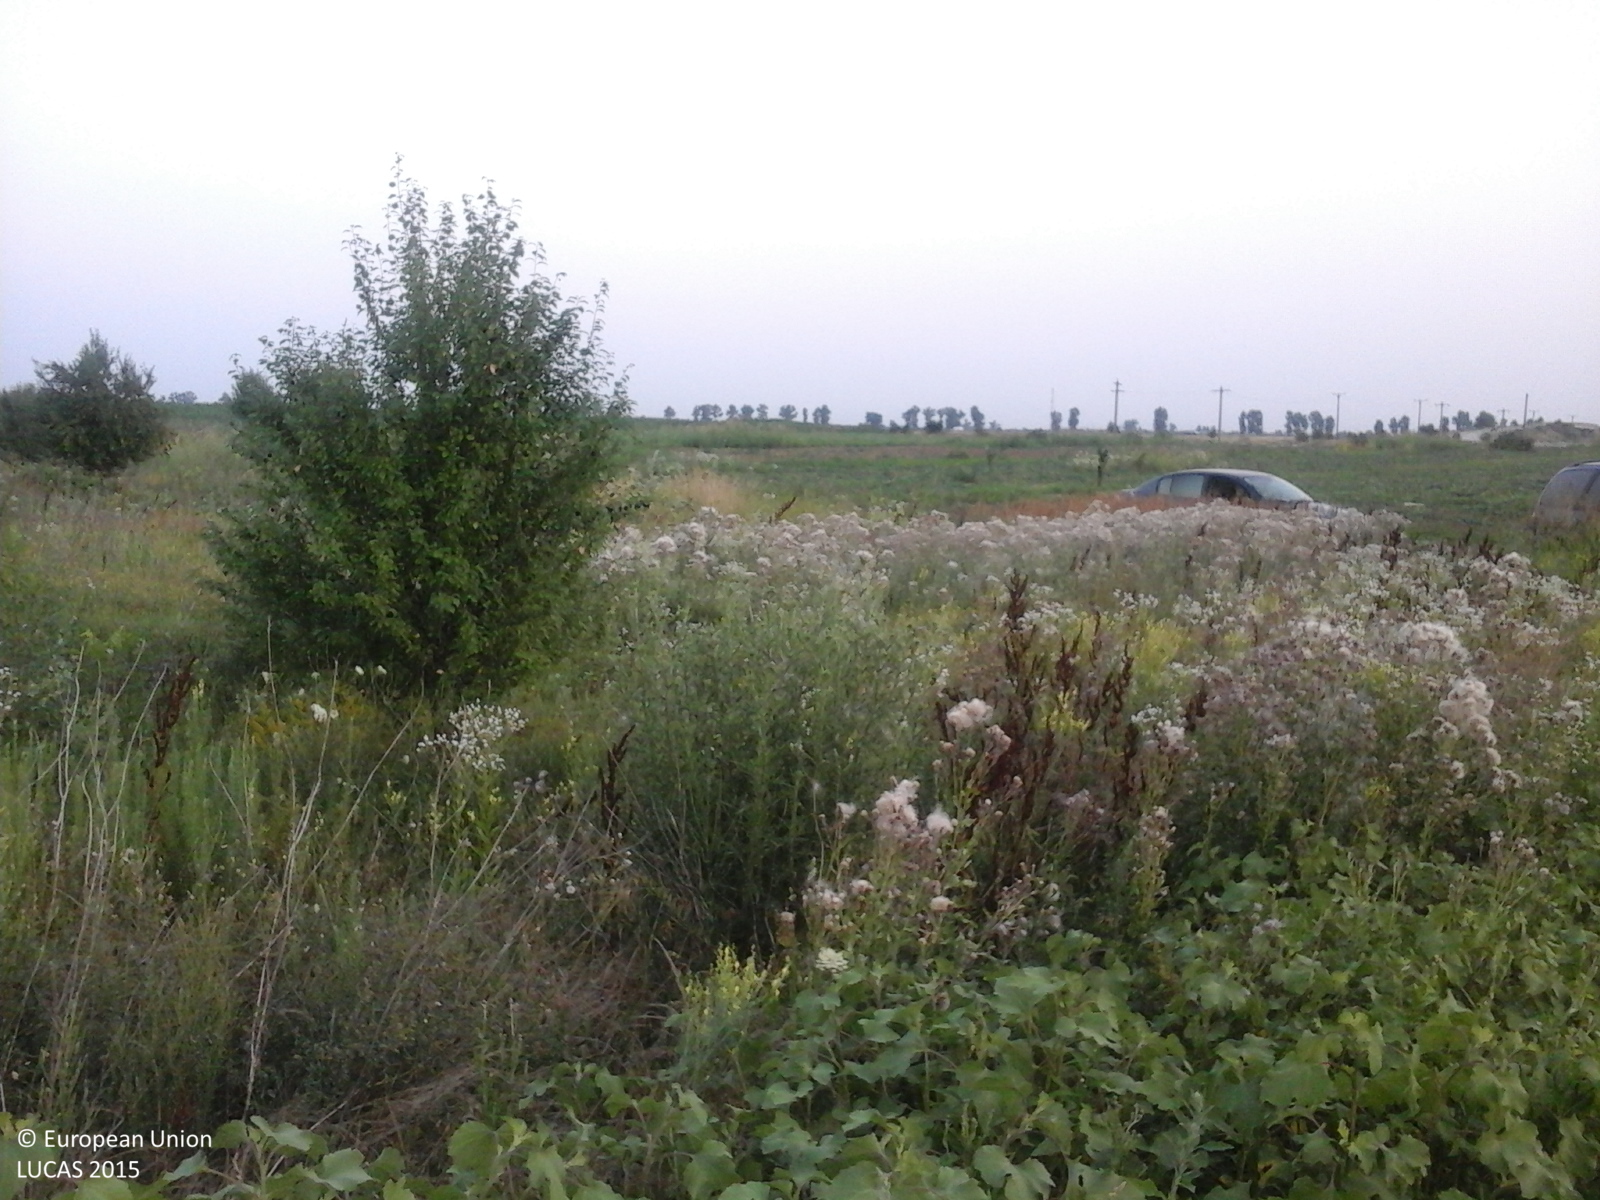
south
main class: Cropland
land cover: Other fresh vegetables
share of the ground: 50 - 75 %
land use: Agriculture (excluding fallow land and kitchen gardens)
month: July
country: RO
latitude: 44.5508
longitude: 25.5128
